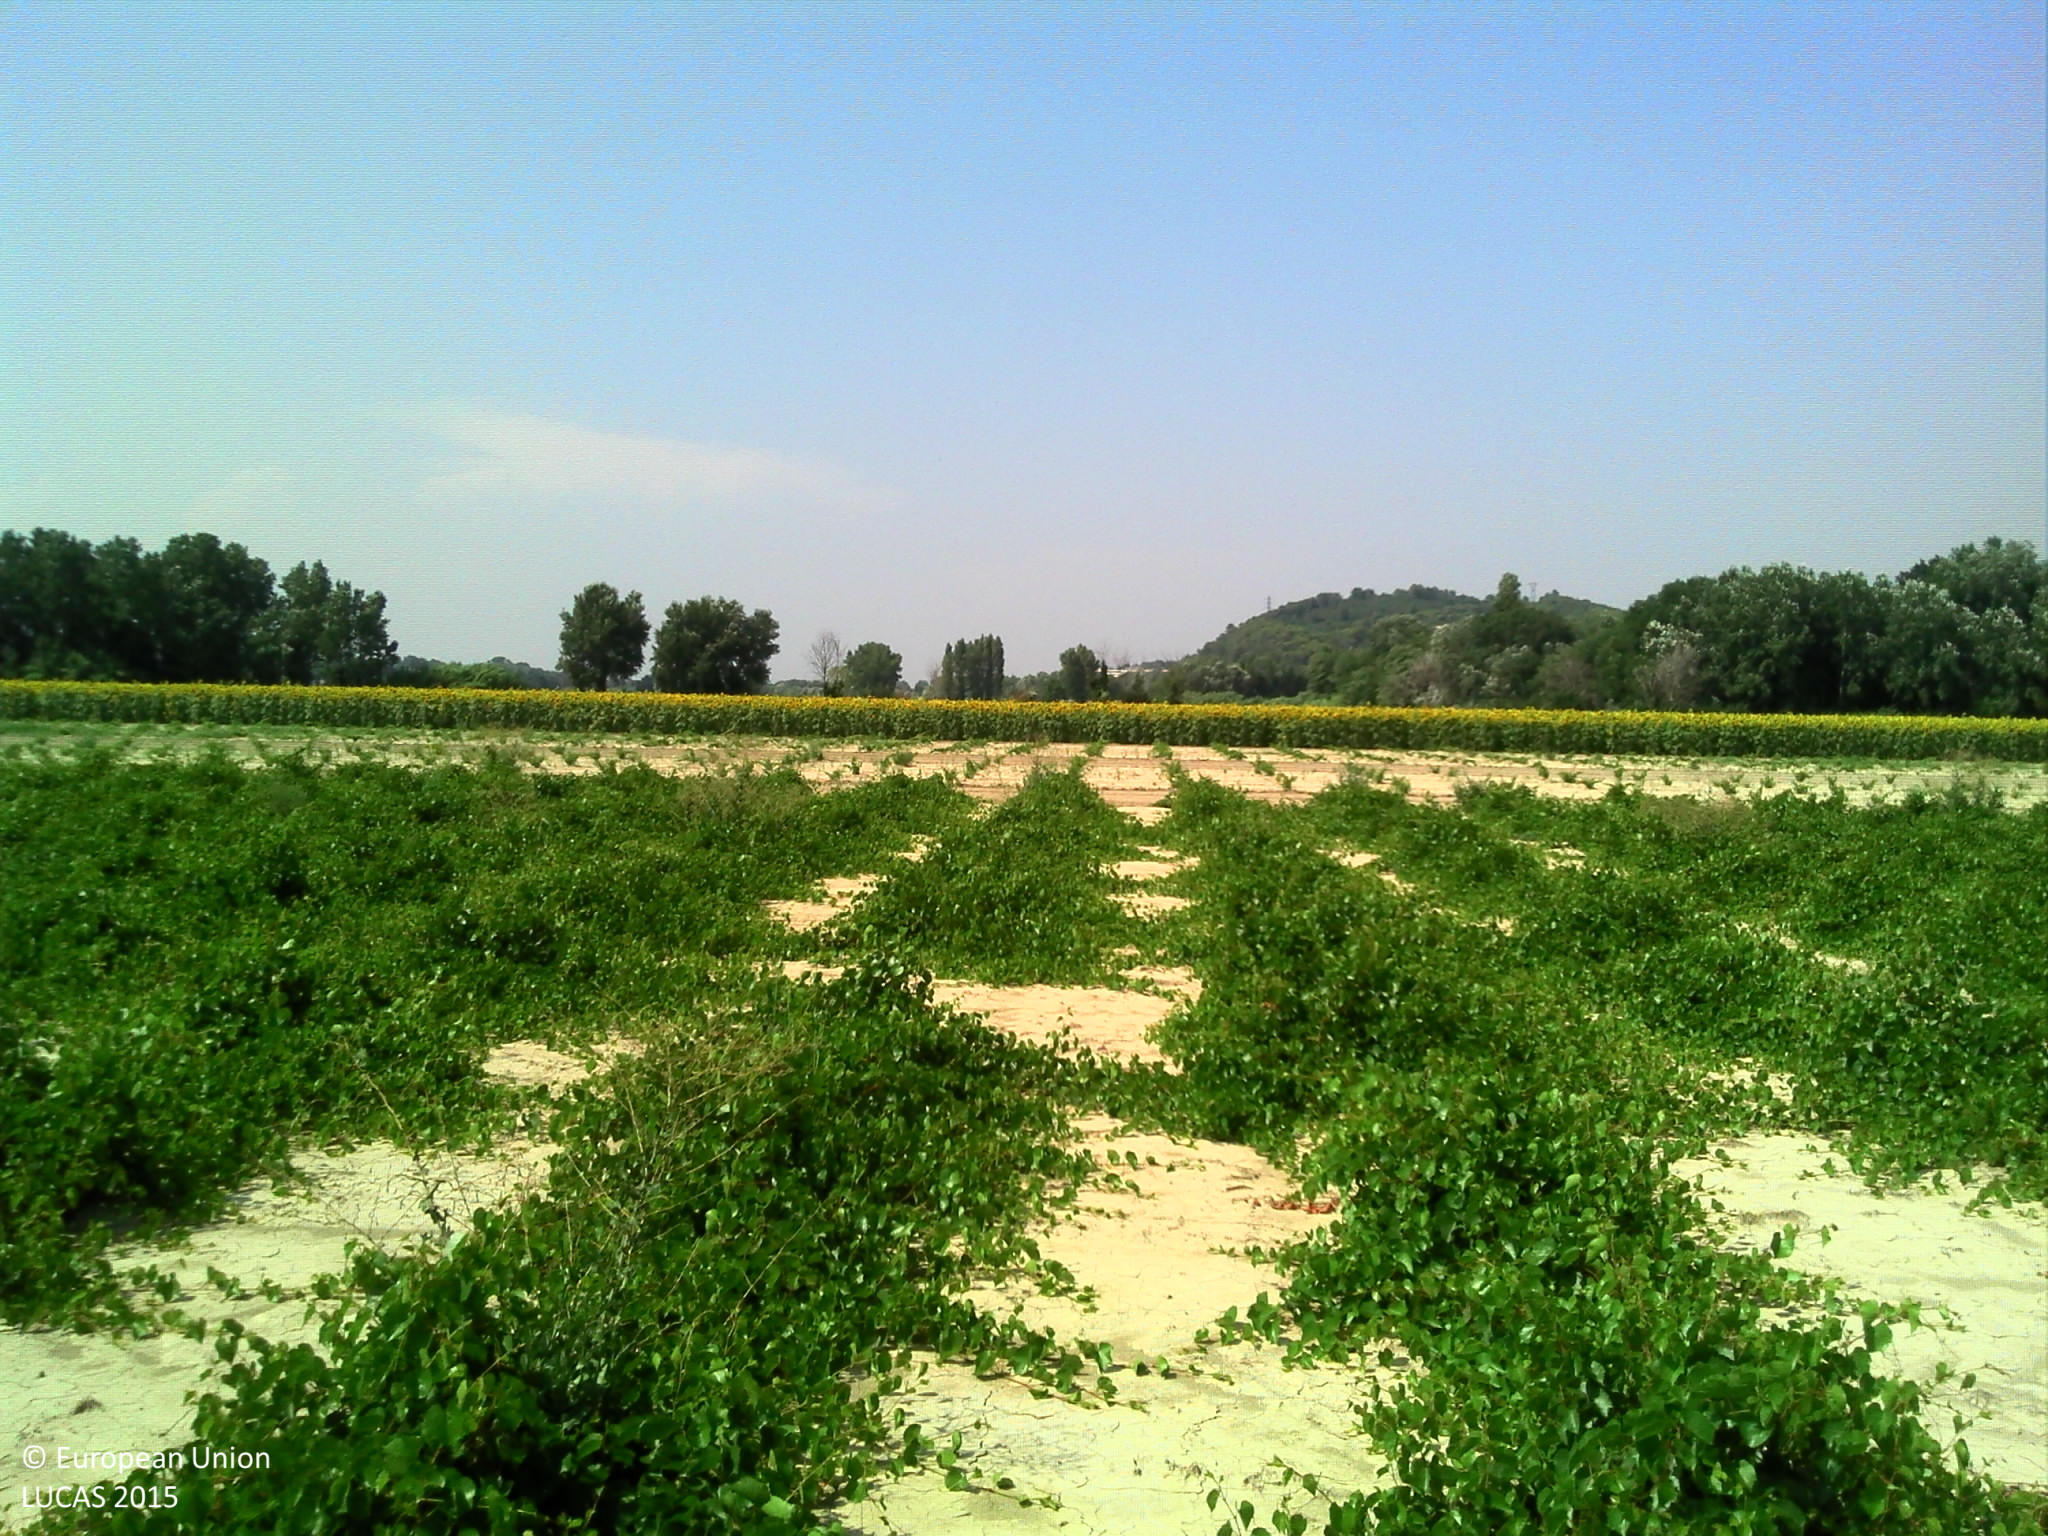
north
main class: Cropland
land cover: Nurseries
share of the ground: 50 - 75 %
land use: Agriculture (excluding fallow land and kitchen gardens)
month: July
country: FR
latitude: 44.2158
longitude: 4.7133
